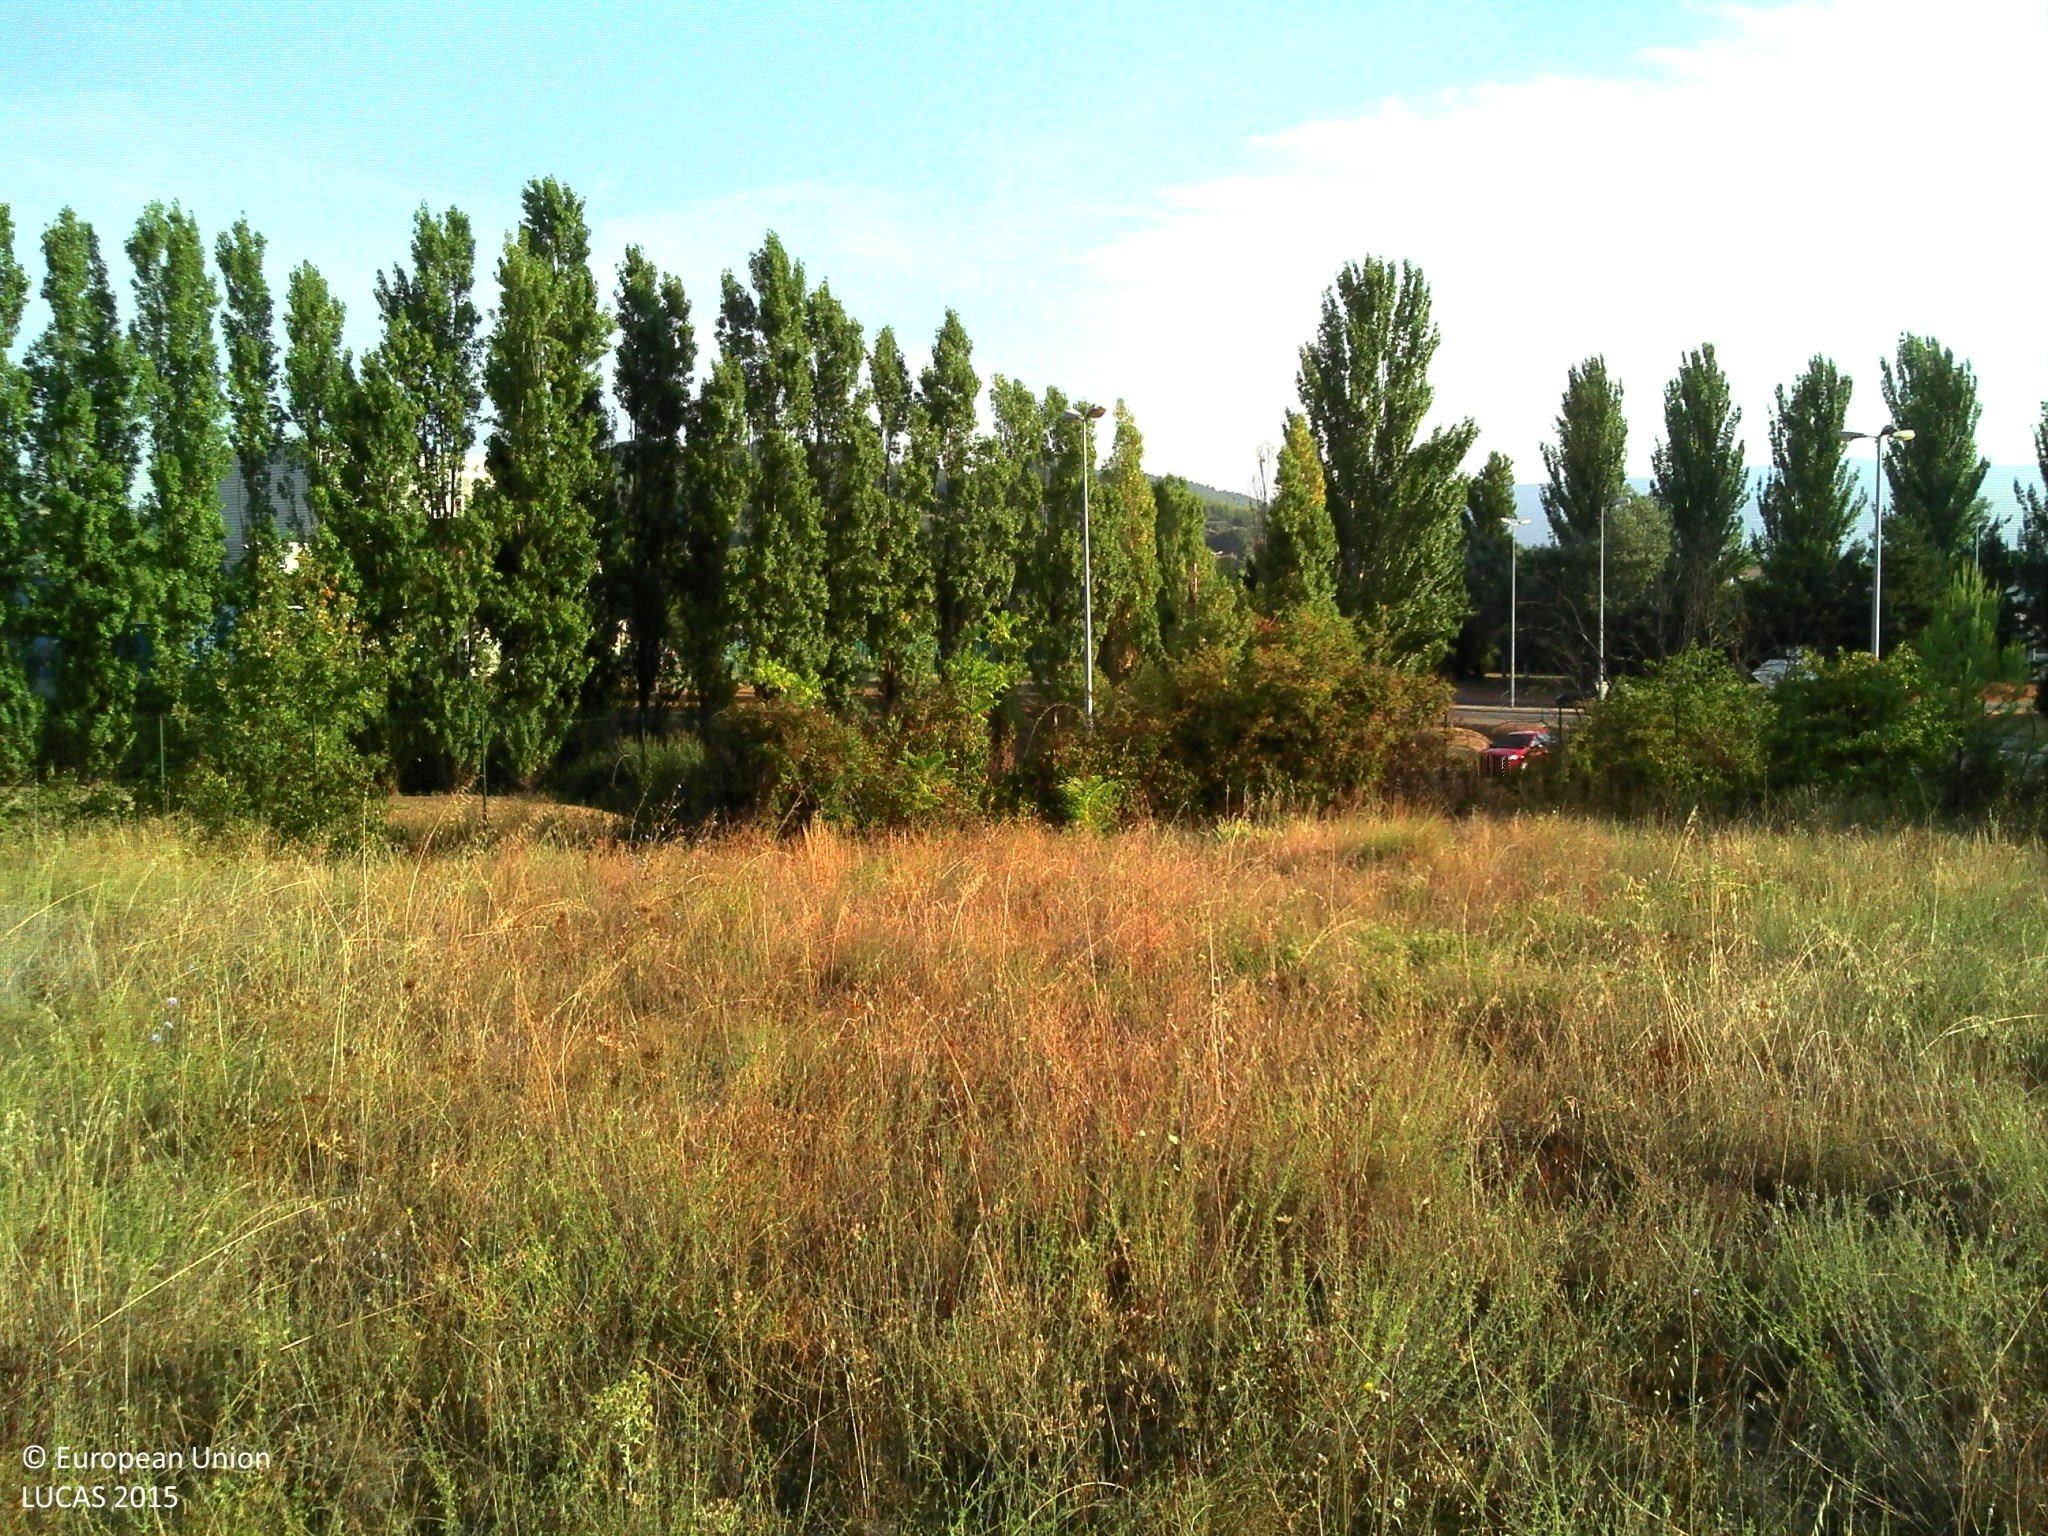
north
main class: Grassland
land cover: Spontaneously vegetated surfaces
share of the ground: > 75 %
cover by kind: herbaceous plants 80 %, unconsolidated bare surface 10 %, shrubs 5 %, lichens and mosses 5 %
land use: Semi-natural and natural areas not in use
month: August
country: FR
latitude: 43.8858
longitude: 5.3659
